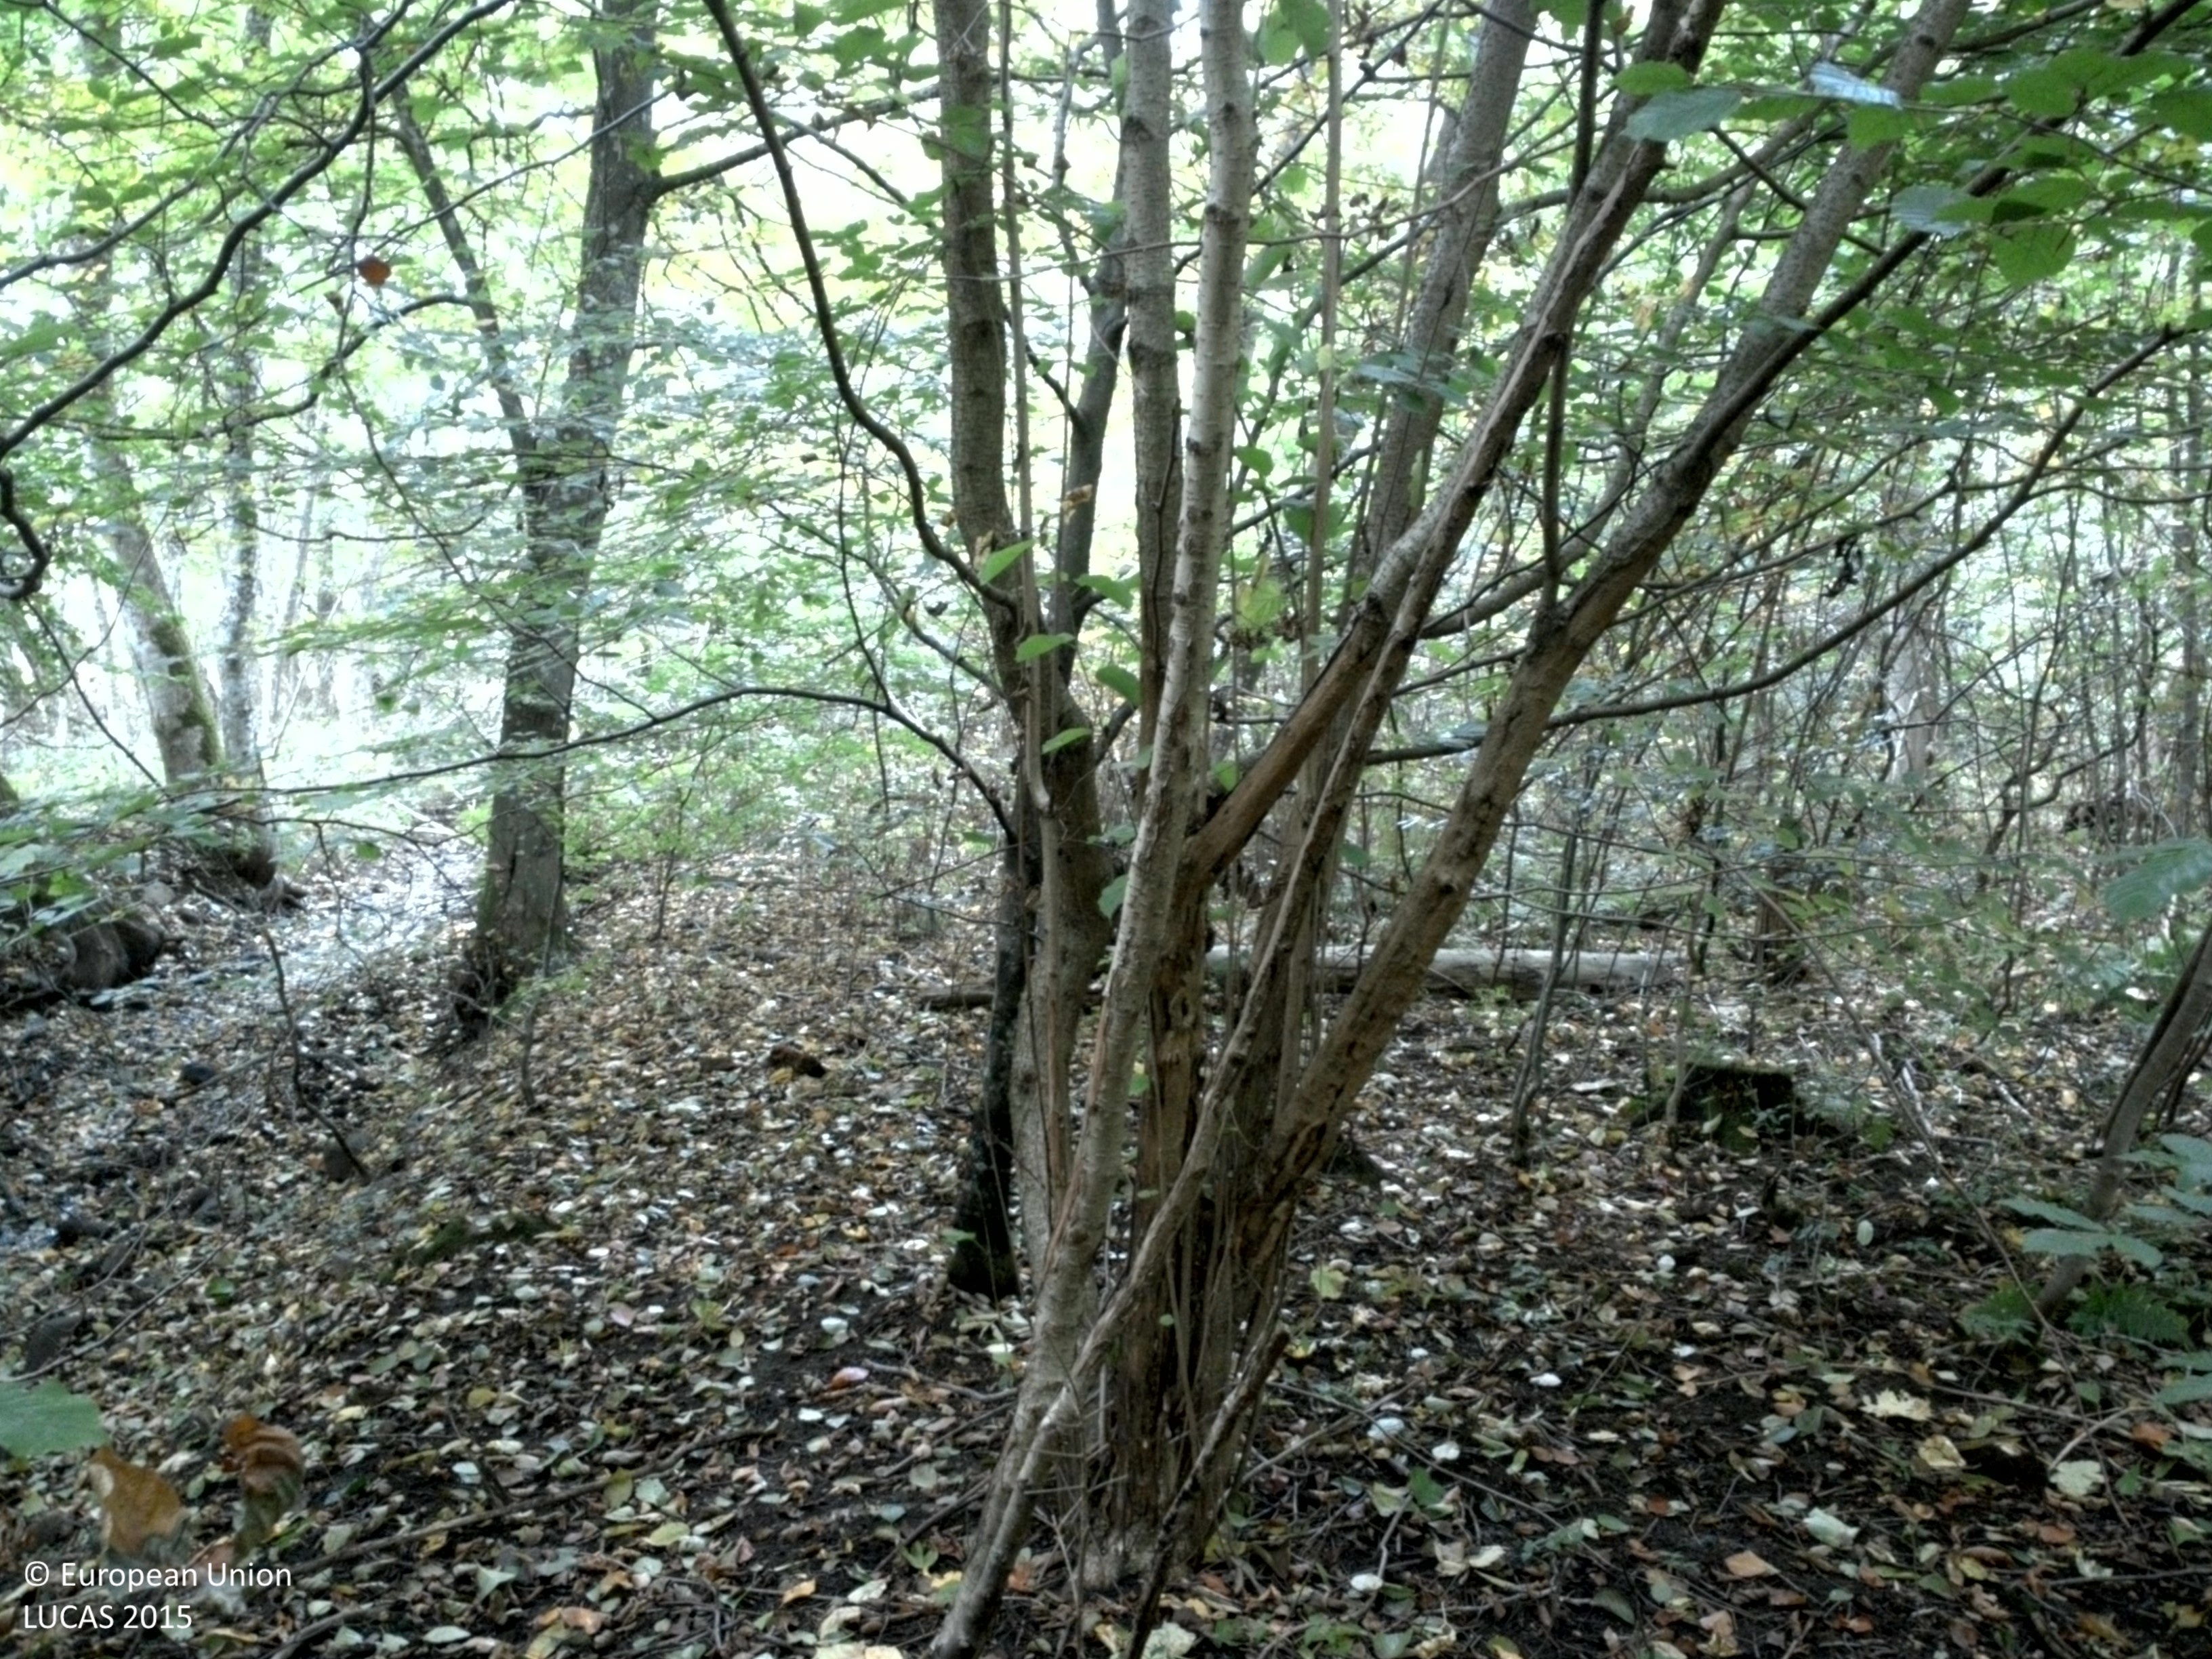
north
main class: Woodland
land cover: Broadleaved woodland
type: beech forest
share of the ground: > 75 %
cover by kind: broadleaved forest trees 80 %, unconsolidated bare surface 10 %, shrubs 5 %, herbaceous plants 5 %
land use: Forestry
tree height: > 5 m
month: October
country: SE
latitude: 55.6379
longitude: 14.0494
